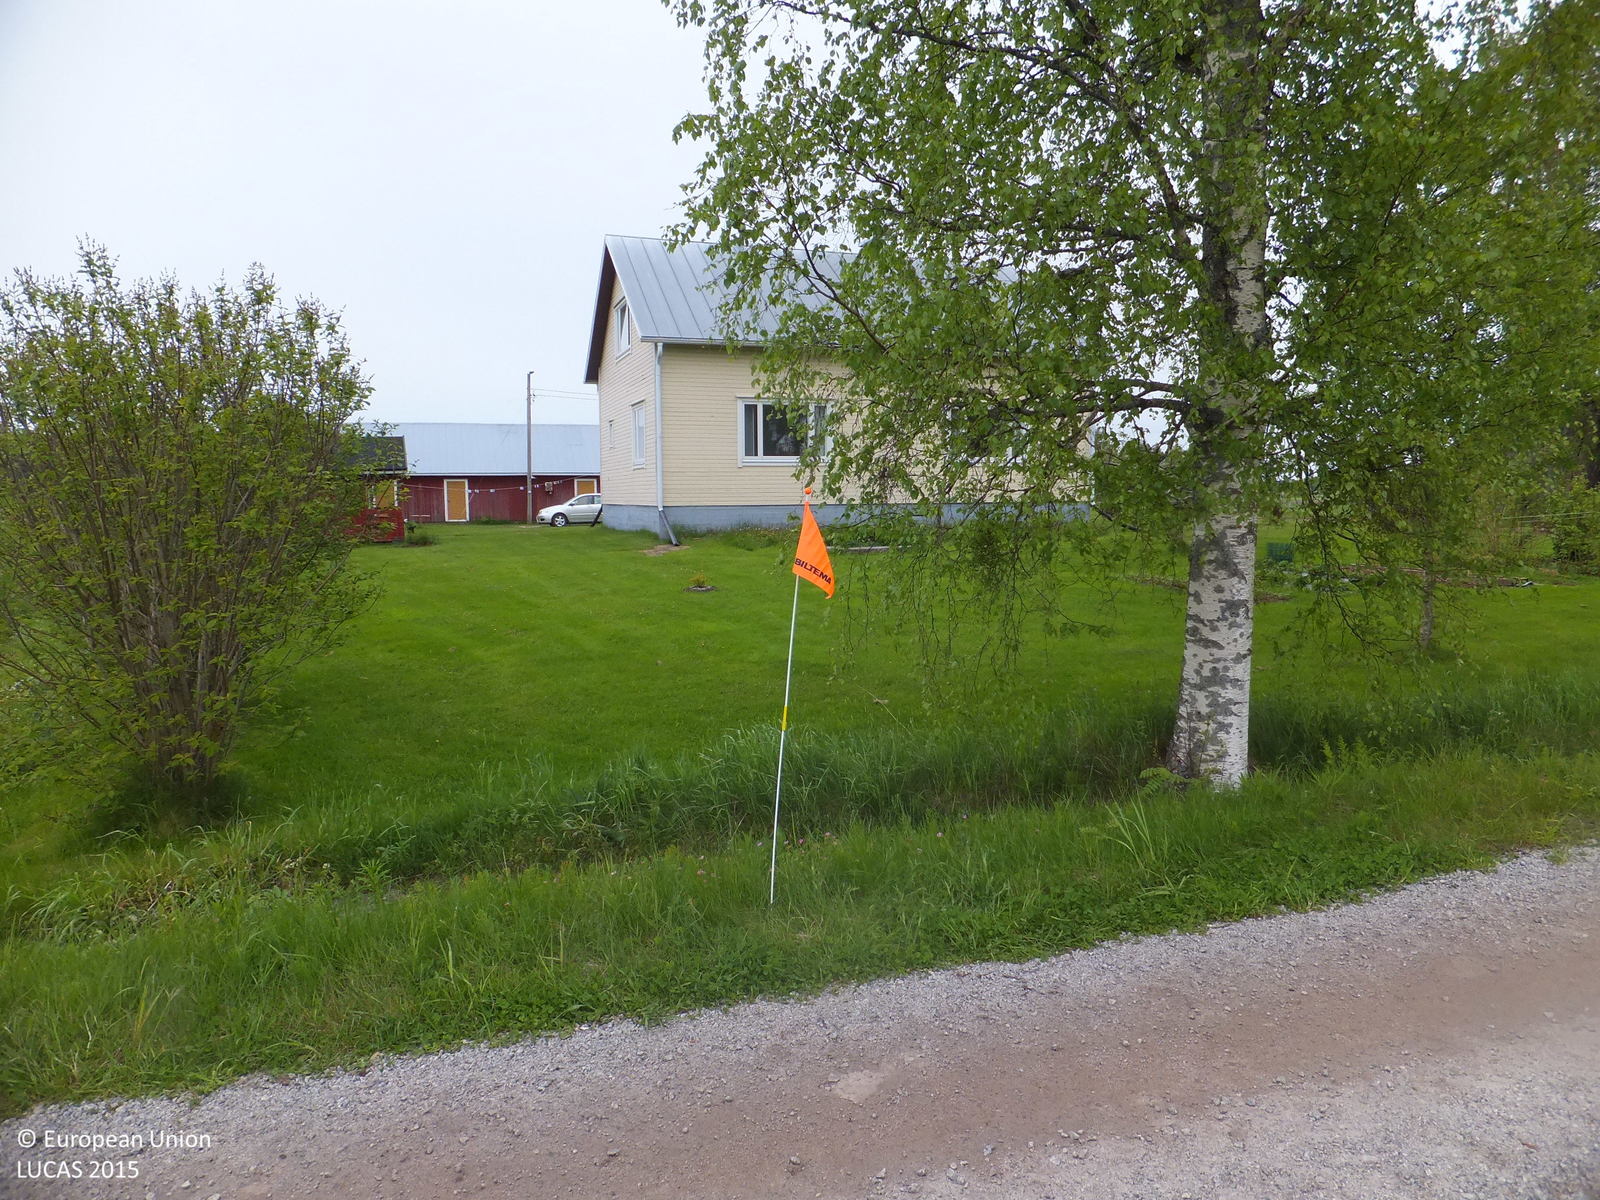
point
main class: Grassland
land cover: Grassland without tree/shrub cover
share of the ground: > 75 %
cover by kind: herbaceous plants 100 %
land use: Residential
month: June
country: FI
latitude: 63.2509
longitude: 22.6172
